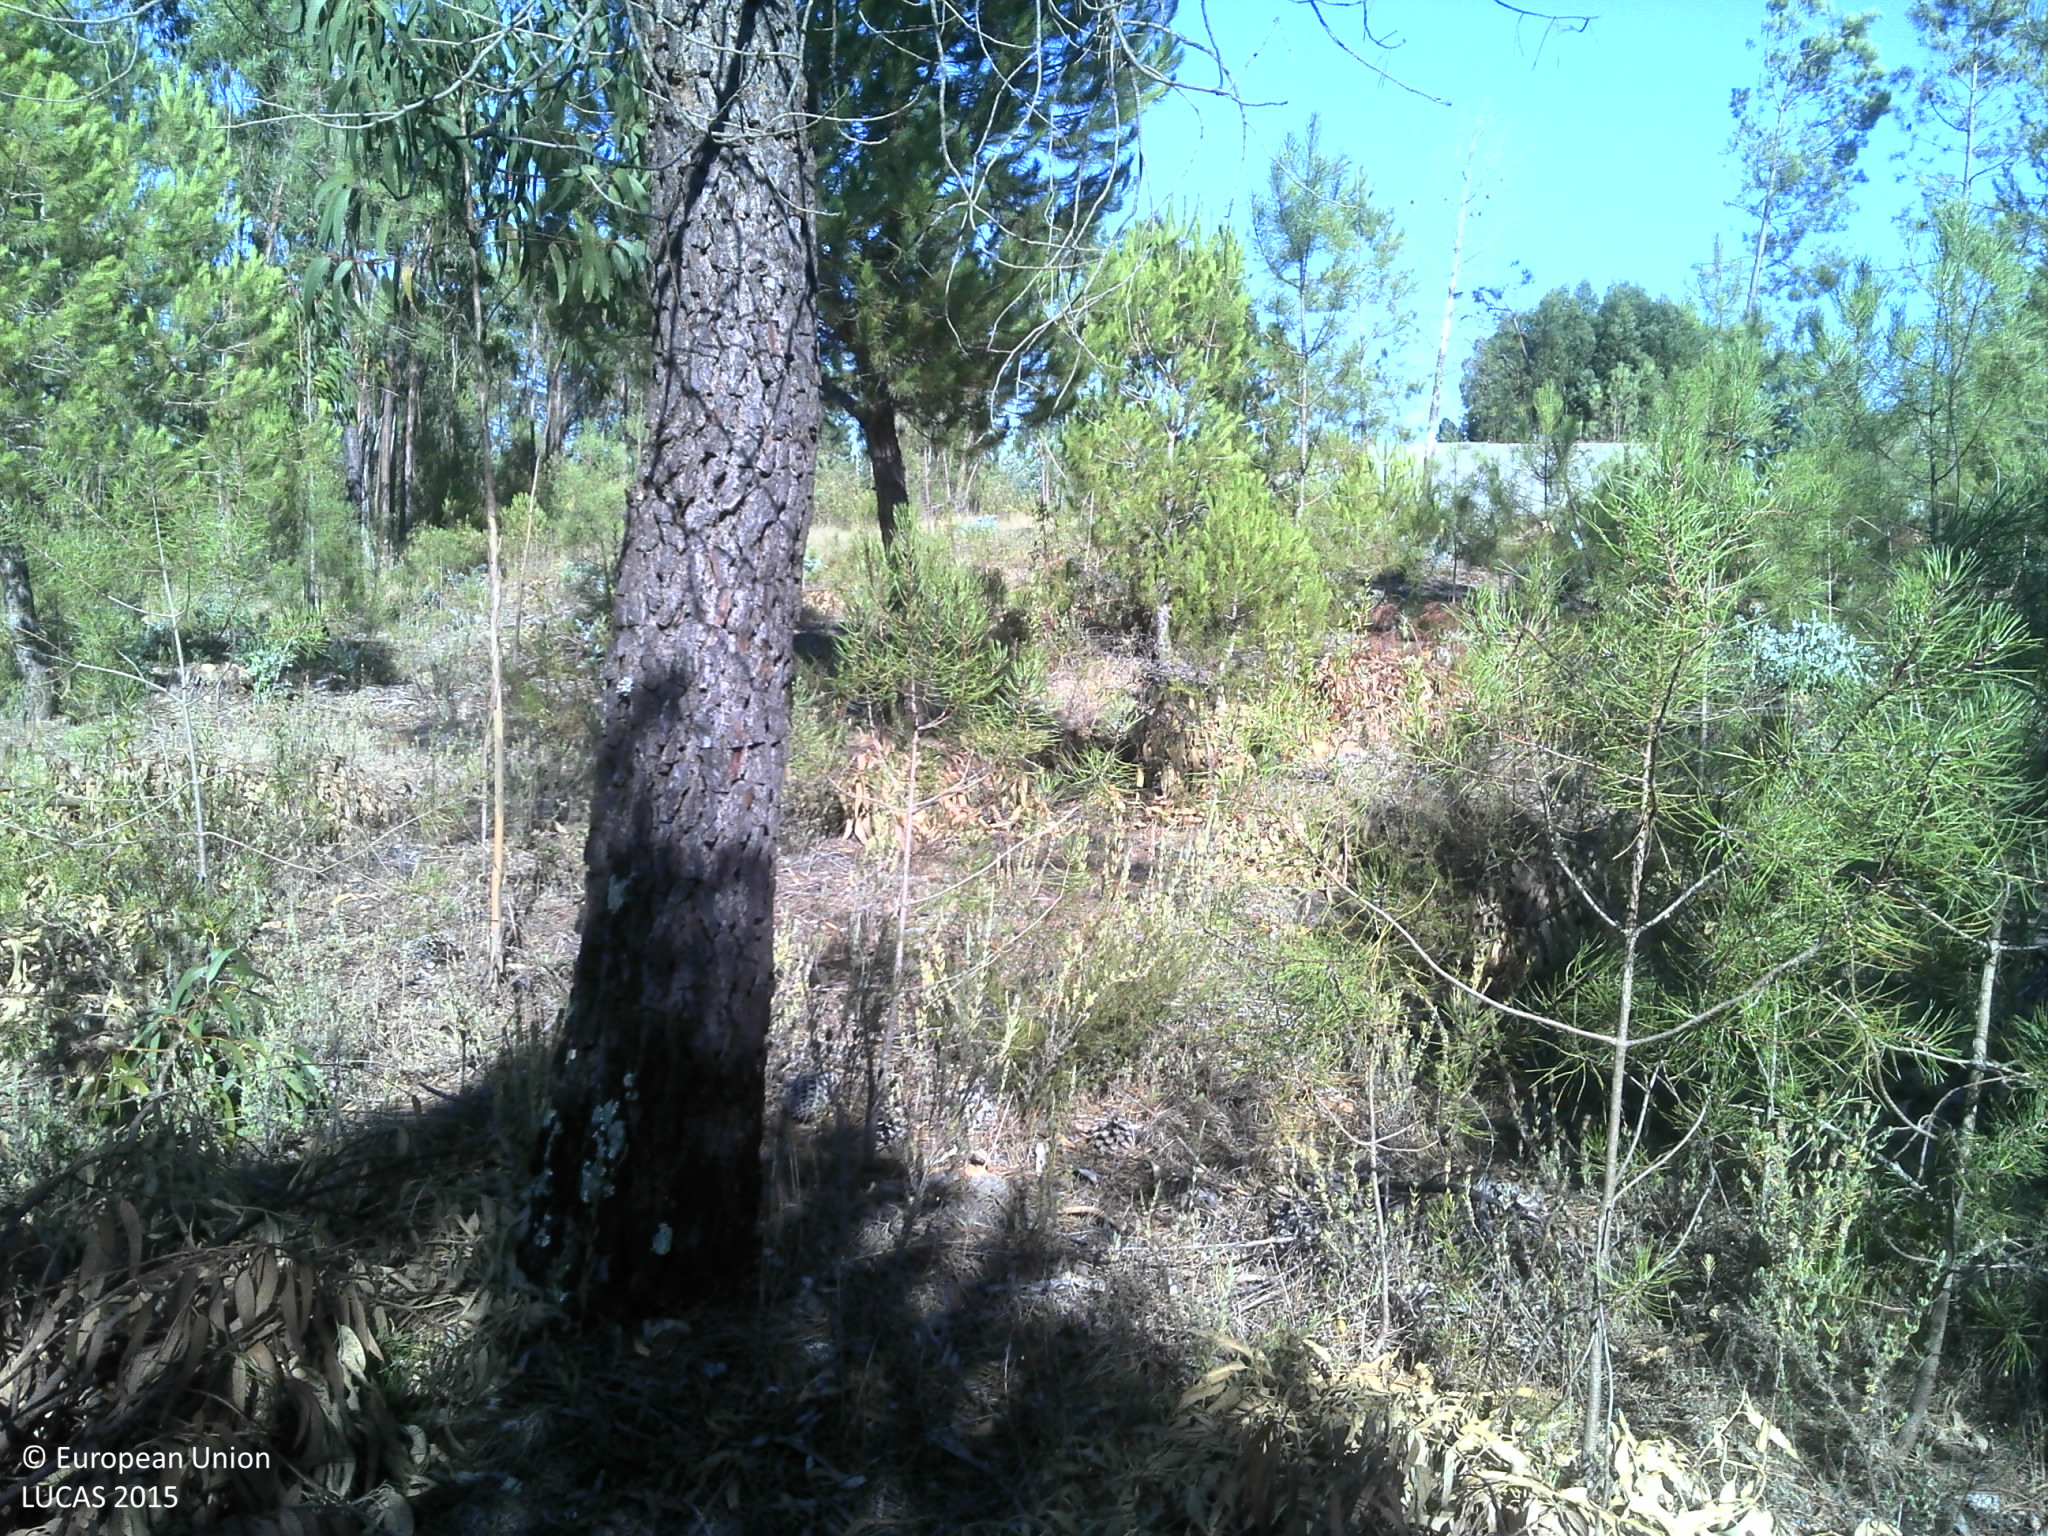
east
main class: Woodland
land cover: Pine dominated coniferous woodland
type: coniferous forest of the mediterranean region
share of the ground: 25 - 50 %
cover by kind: coniferous forest trees 50 %, unconsolidated bare surface 45 %, shrubs 5 %
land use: Forestry
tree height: < 5 m
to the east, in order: Pine dominated coniferous woodland; Pine dominated mixed woodland; Broadleaved woodland; Shrubland without tree cover; Tracks; Broadleaved woodland; Grassland without tree/shrub cover; Shrubland without tree cover; Broadleaved woodland; Pine dominated coniferous woodland
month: July
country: PT
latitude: 39.0383
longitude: -8.6328
